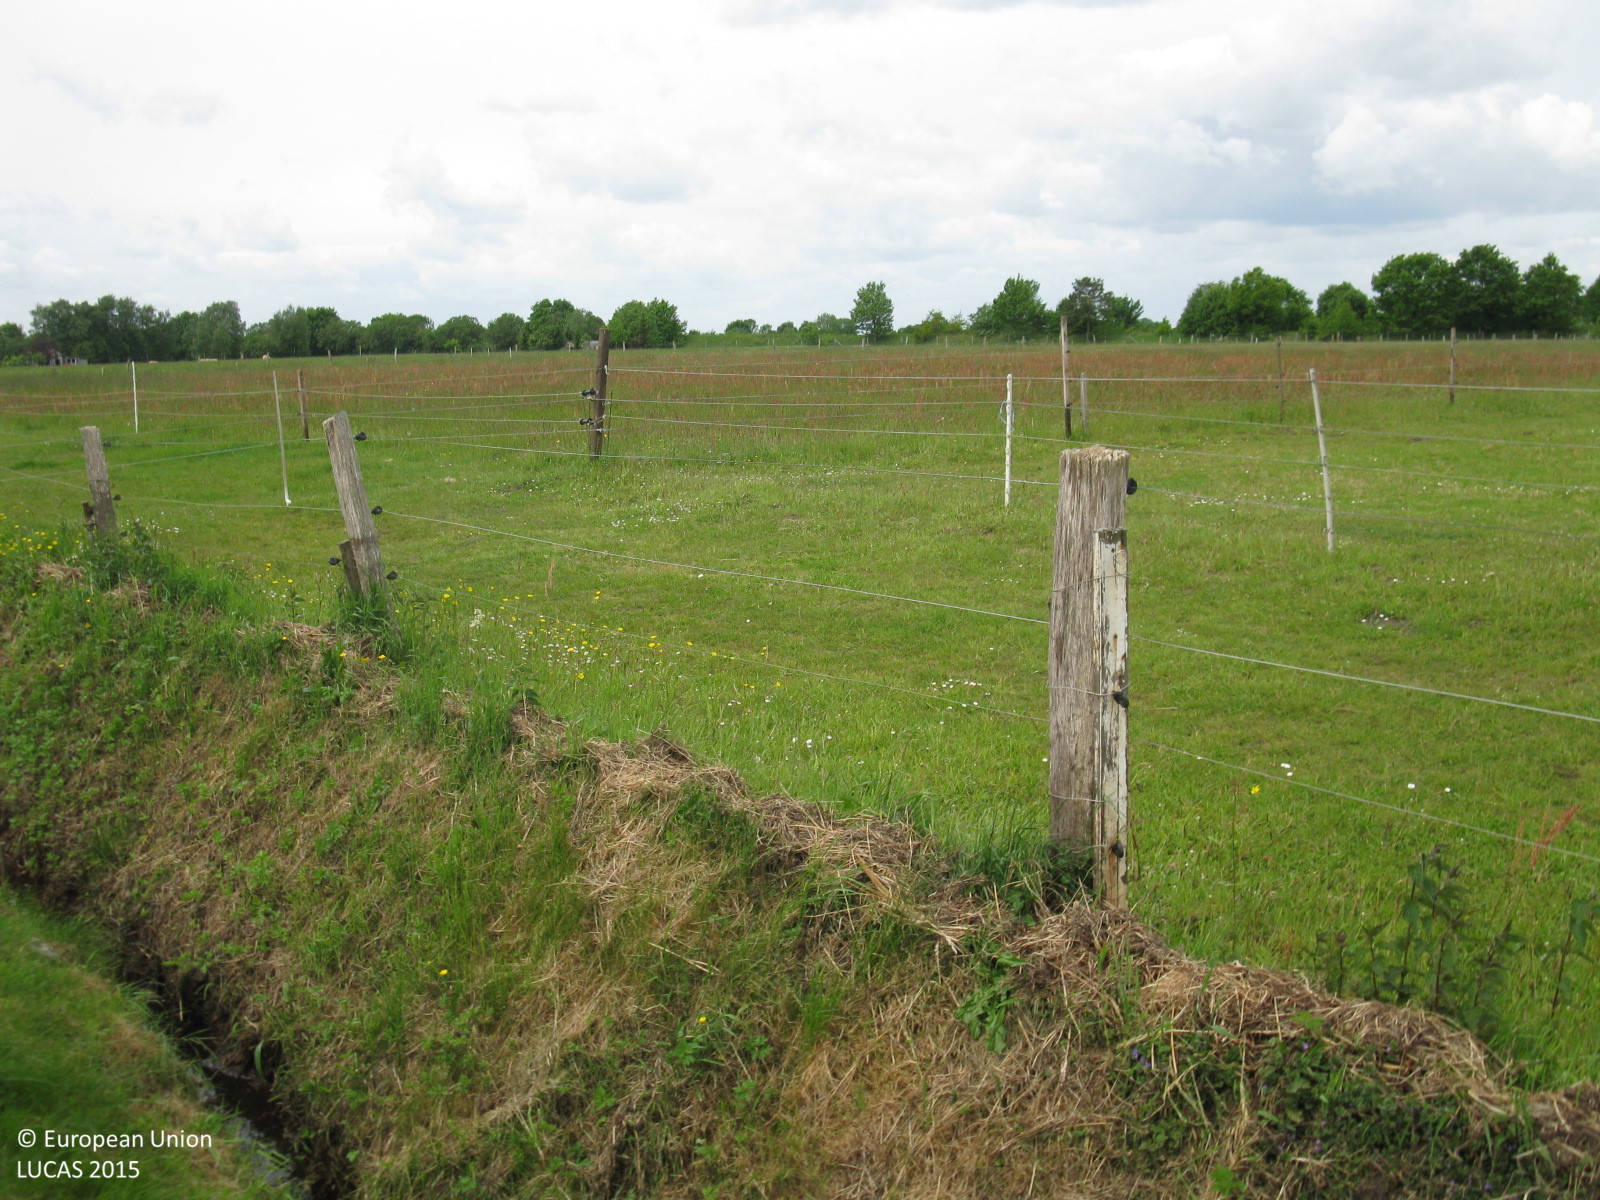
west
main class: Grassland
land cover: Grassland without tree/shrub cover
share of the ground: > 75 %
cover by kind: herbaceous plants 100 %
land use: Agriculture (excluding fallow land and kitchen gardens)
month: June
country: DE
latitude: 53.1739
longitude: 7.2926
